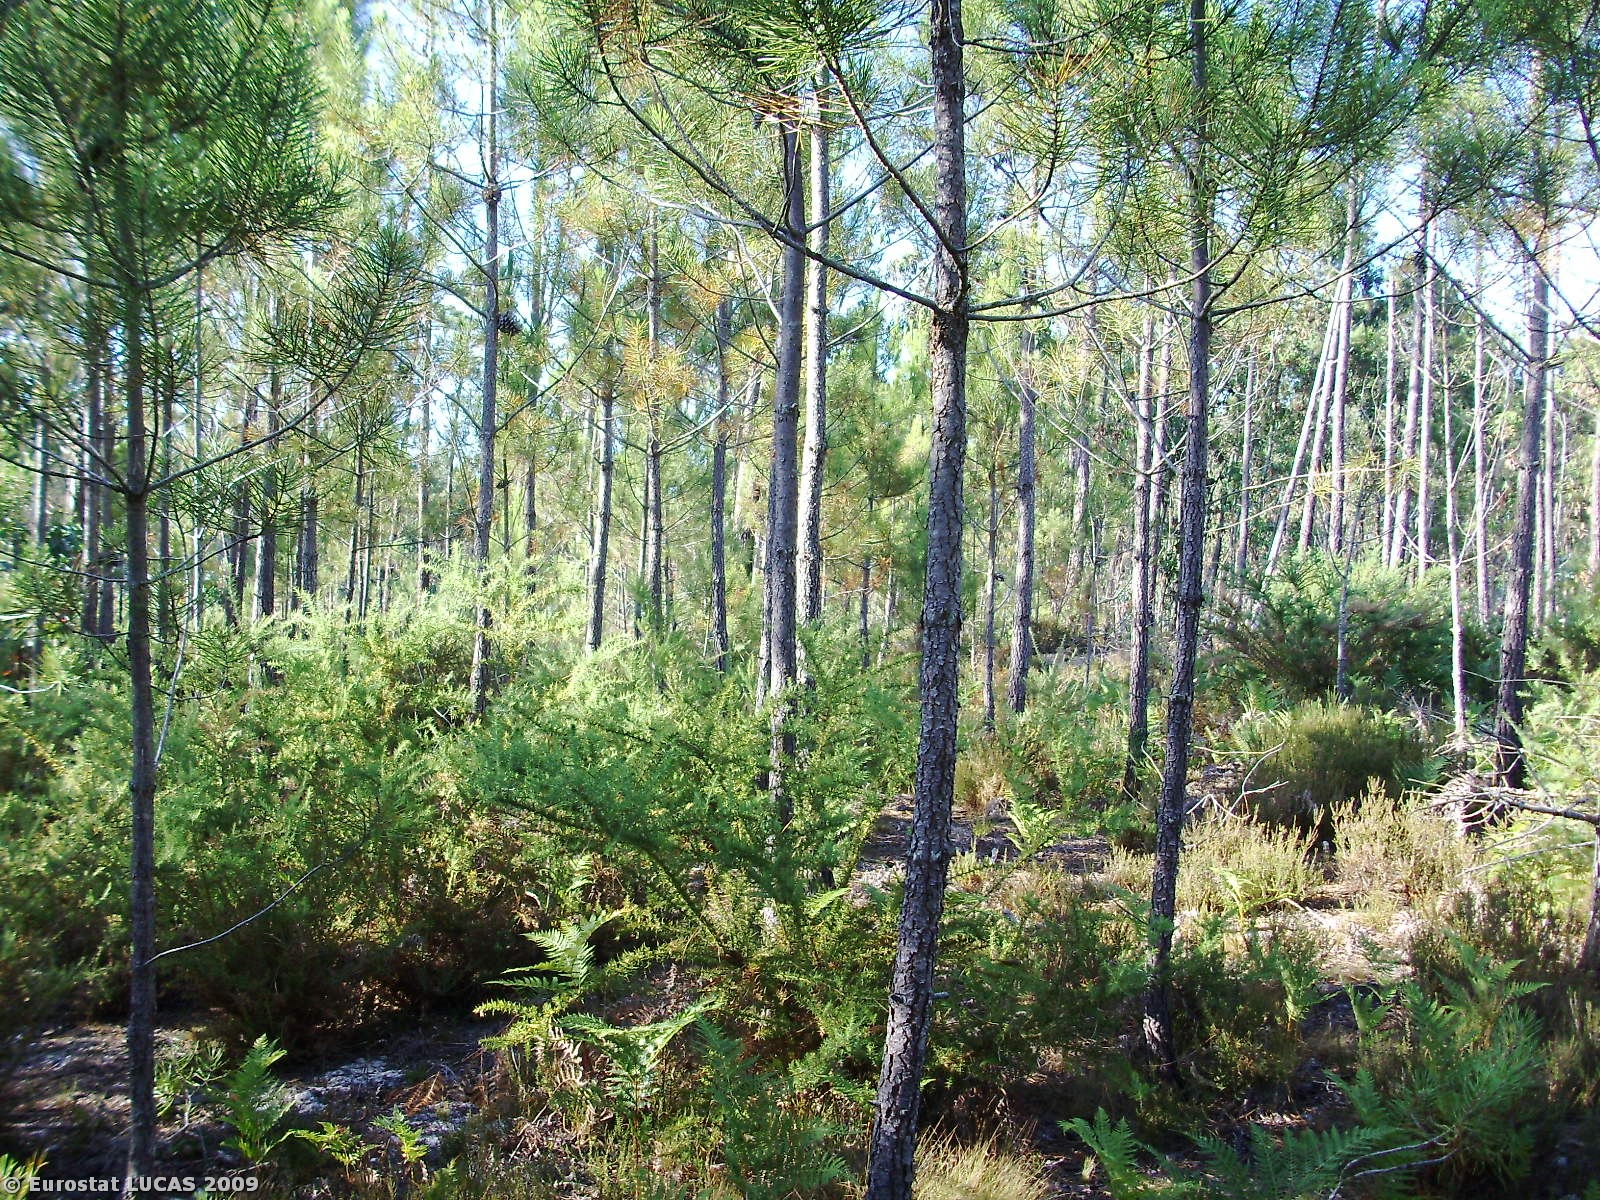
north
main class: Woodland
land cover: Coniferous woodland
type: coniferous forest of the mediterranean region
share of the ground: 50 - 75 %
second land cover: Shrubland with sparse tree cover
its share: 10 - 25 %
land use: Forestry
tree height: > 5 m
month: July
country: PT
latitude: 39.4522
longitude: -9.1606
